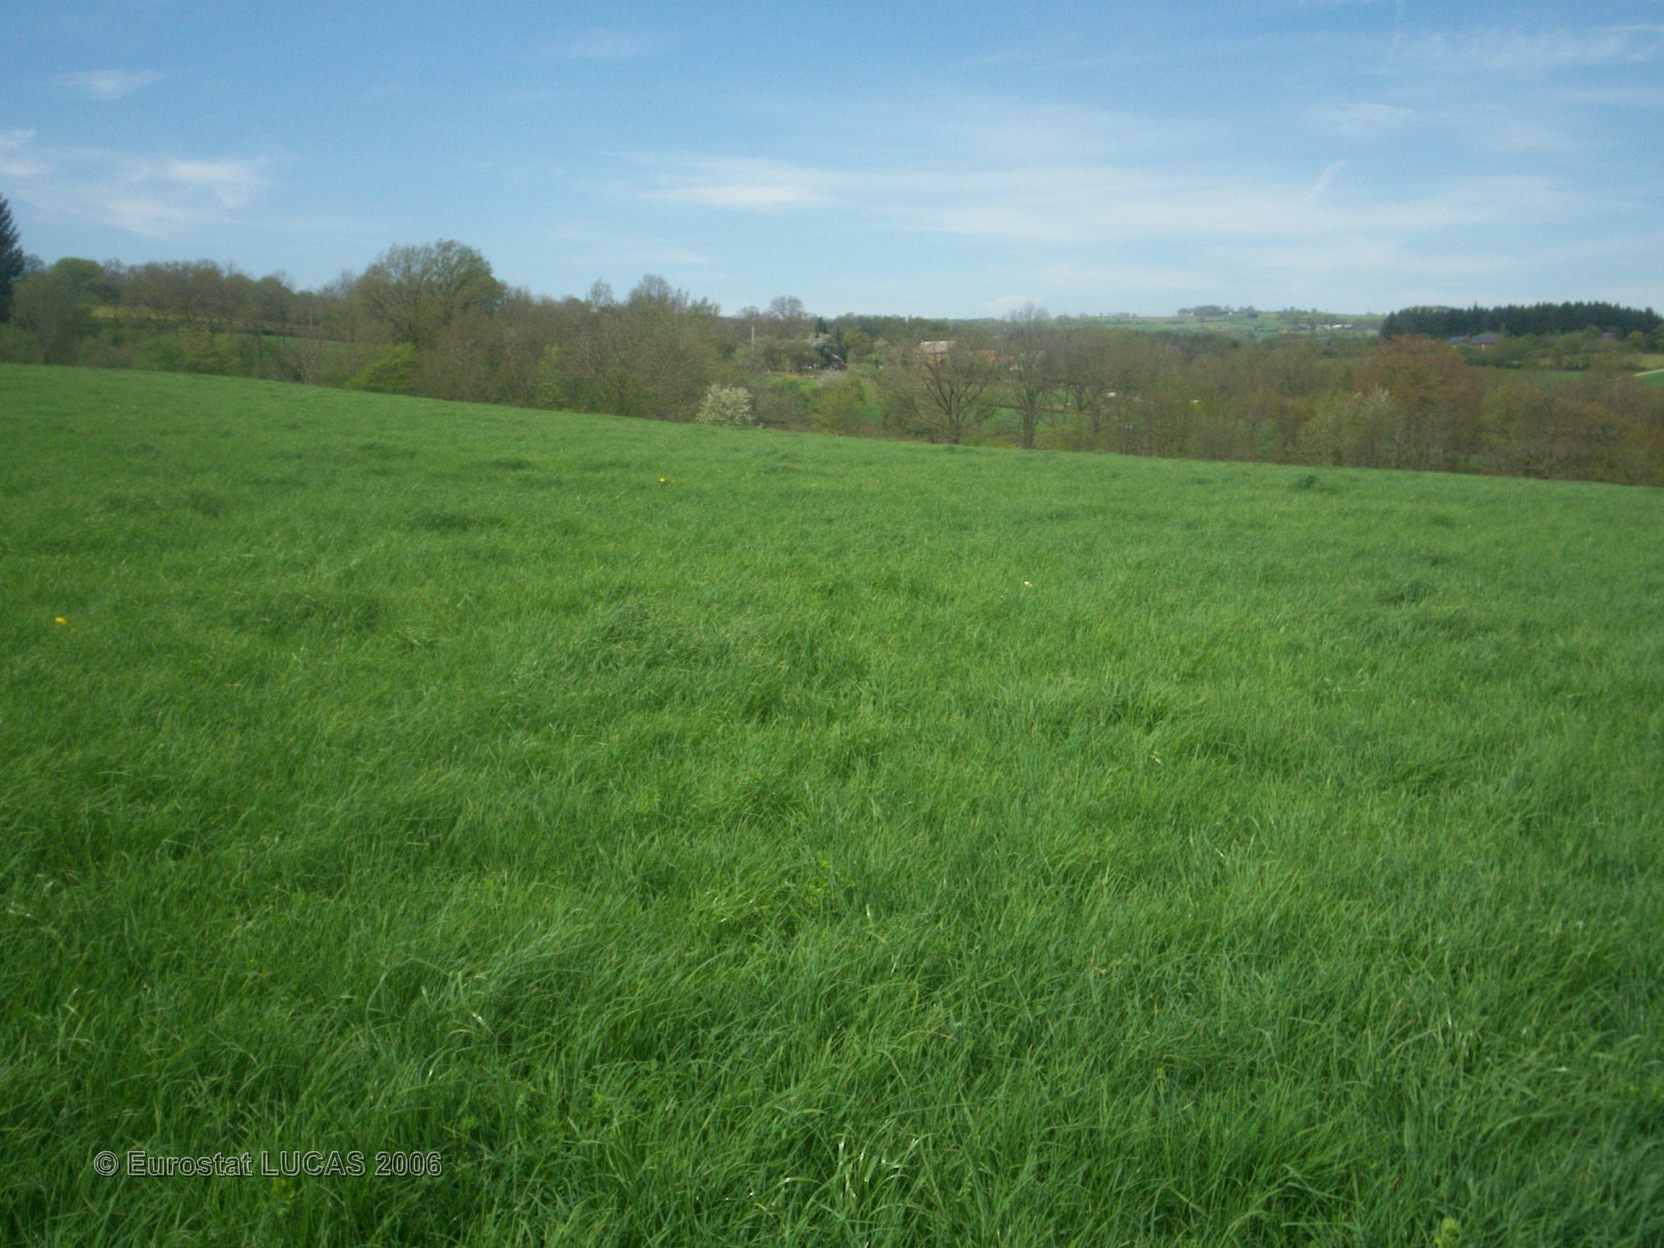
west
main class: Grassland
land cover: Grassland without tree/shrub cover
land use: Agriculture (excluding fallow land and kitchen gardens)
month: May
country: FR
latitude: 46.0610
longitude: 2.9014
